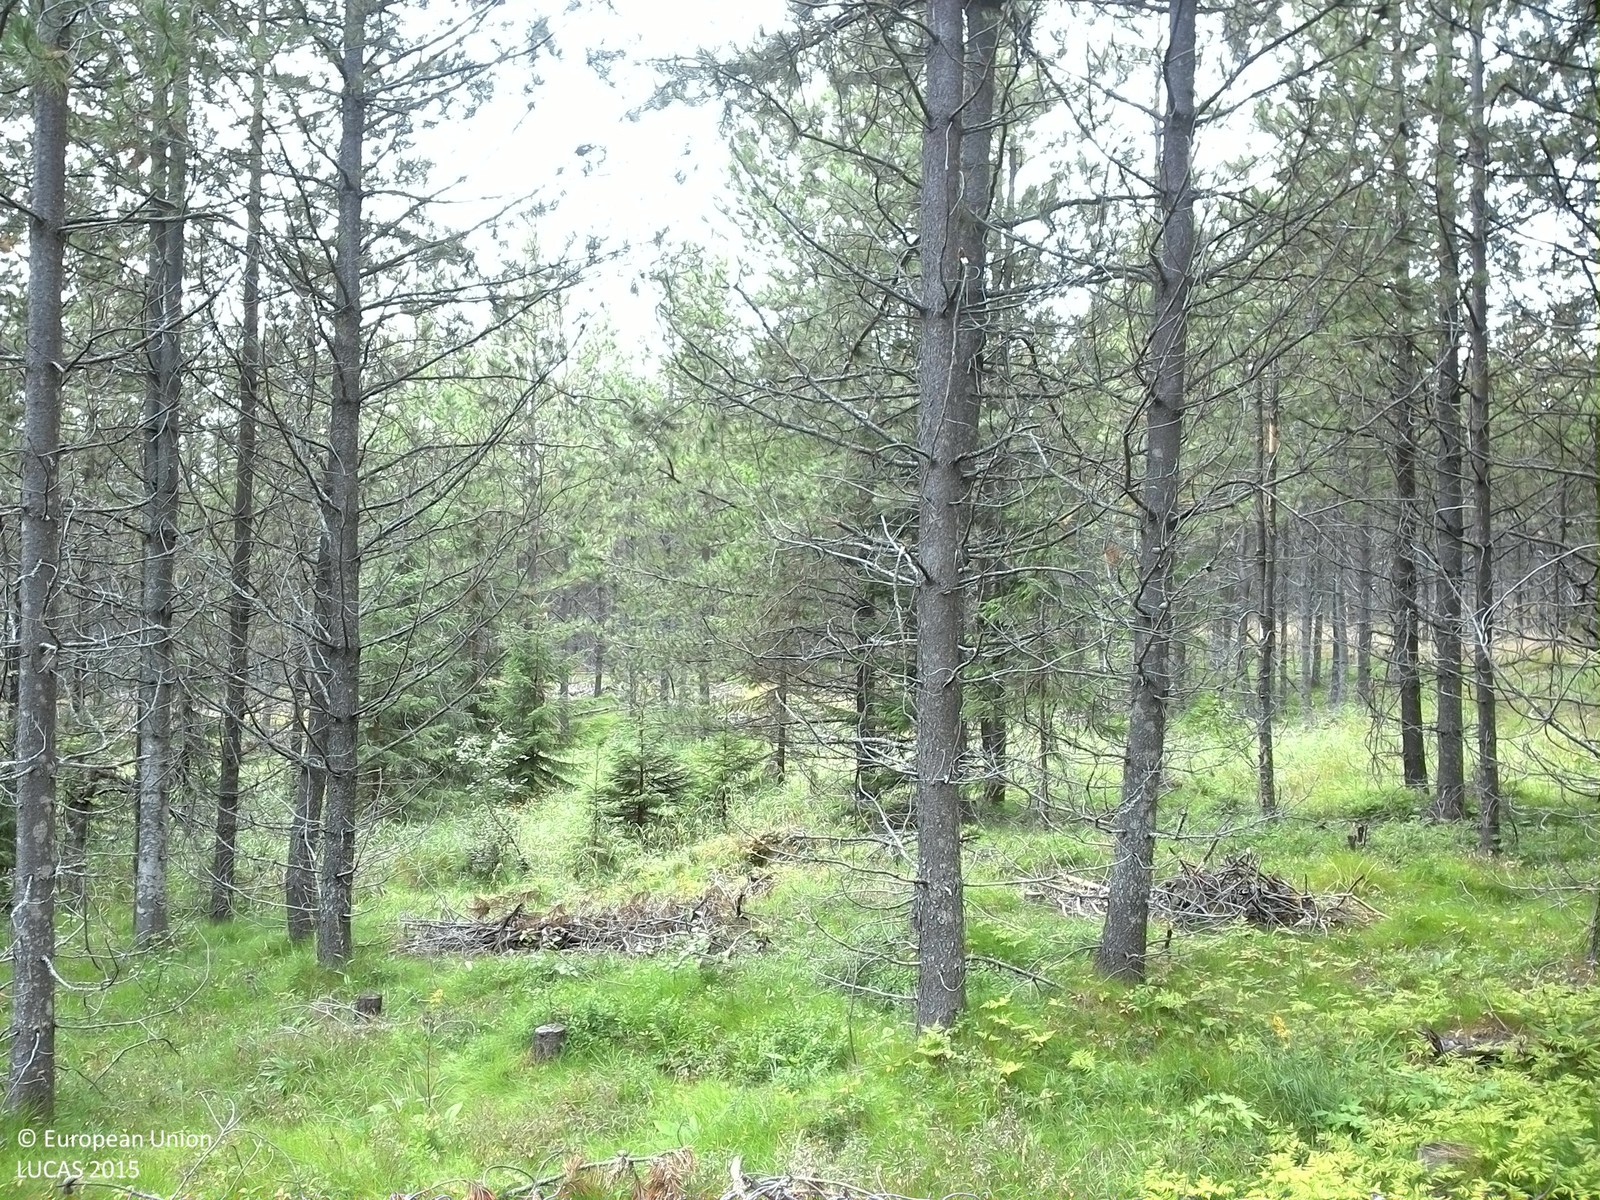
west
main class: Woodland
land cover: Pine dominated coniferous woodland
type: exotic forest
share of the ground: 50 - 75 %
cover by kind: coniferous forest trees 45 %, herbaceous plants 35 %, shrubs 10 %, broadleaved forest trees 5 %, lichens and mosses 5 %
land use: Forestry
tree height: > 5 m
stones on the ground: 10 - 25 %
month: August
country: SE
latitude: 62.8715
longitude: 17.2705
